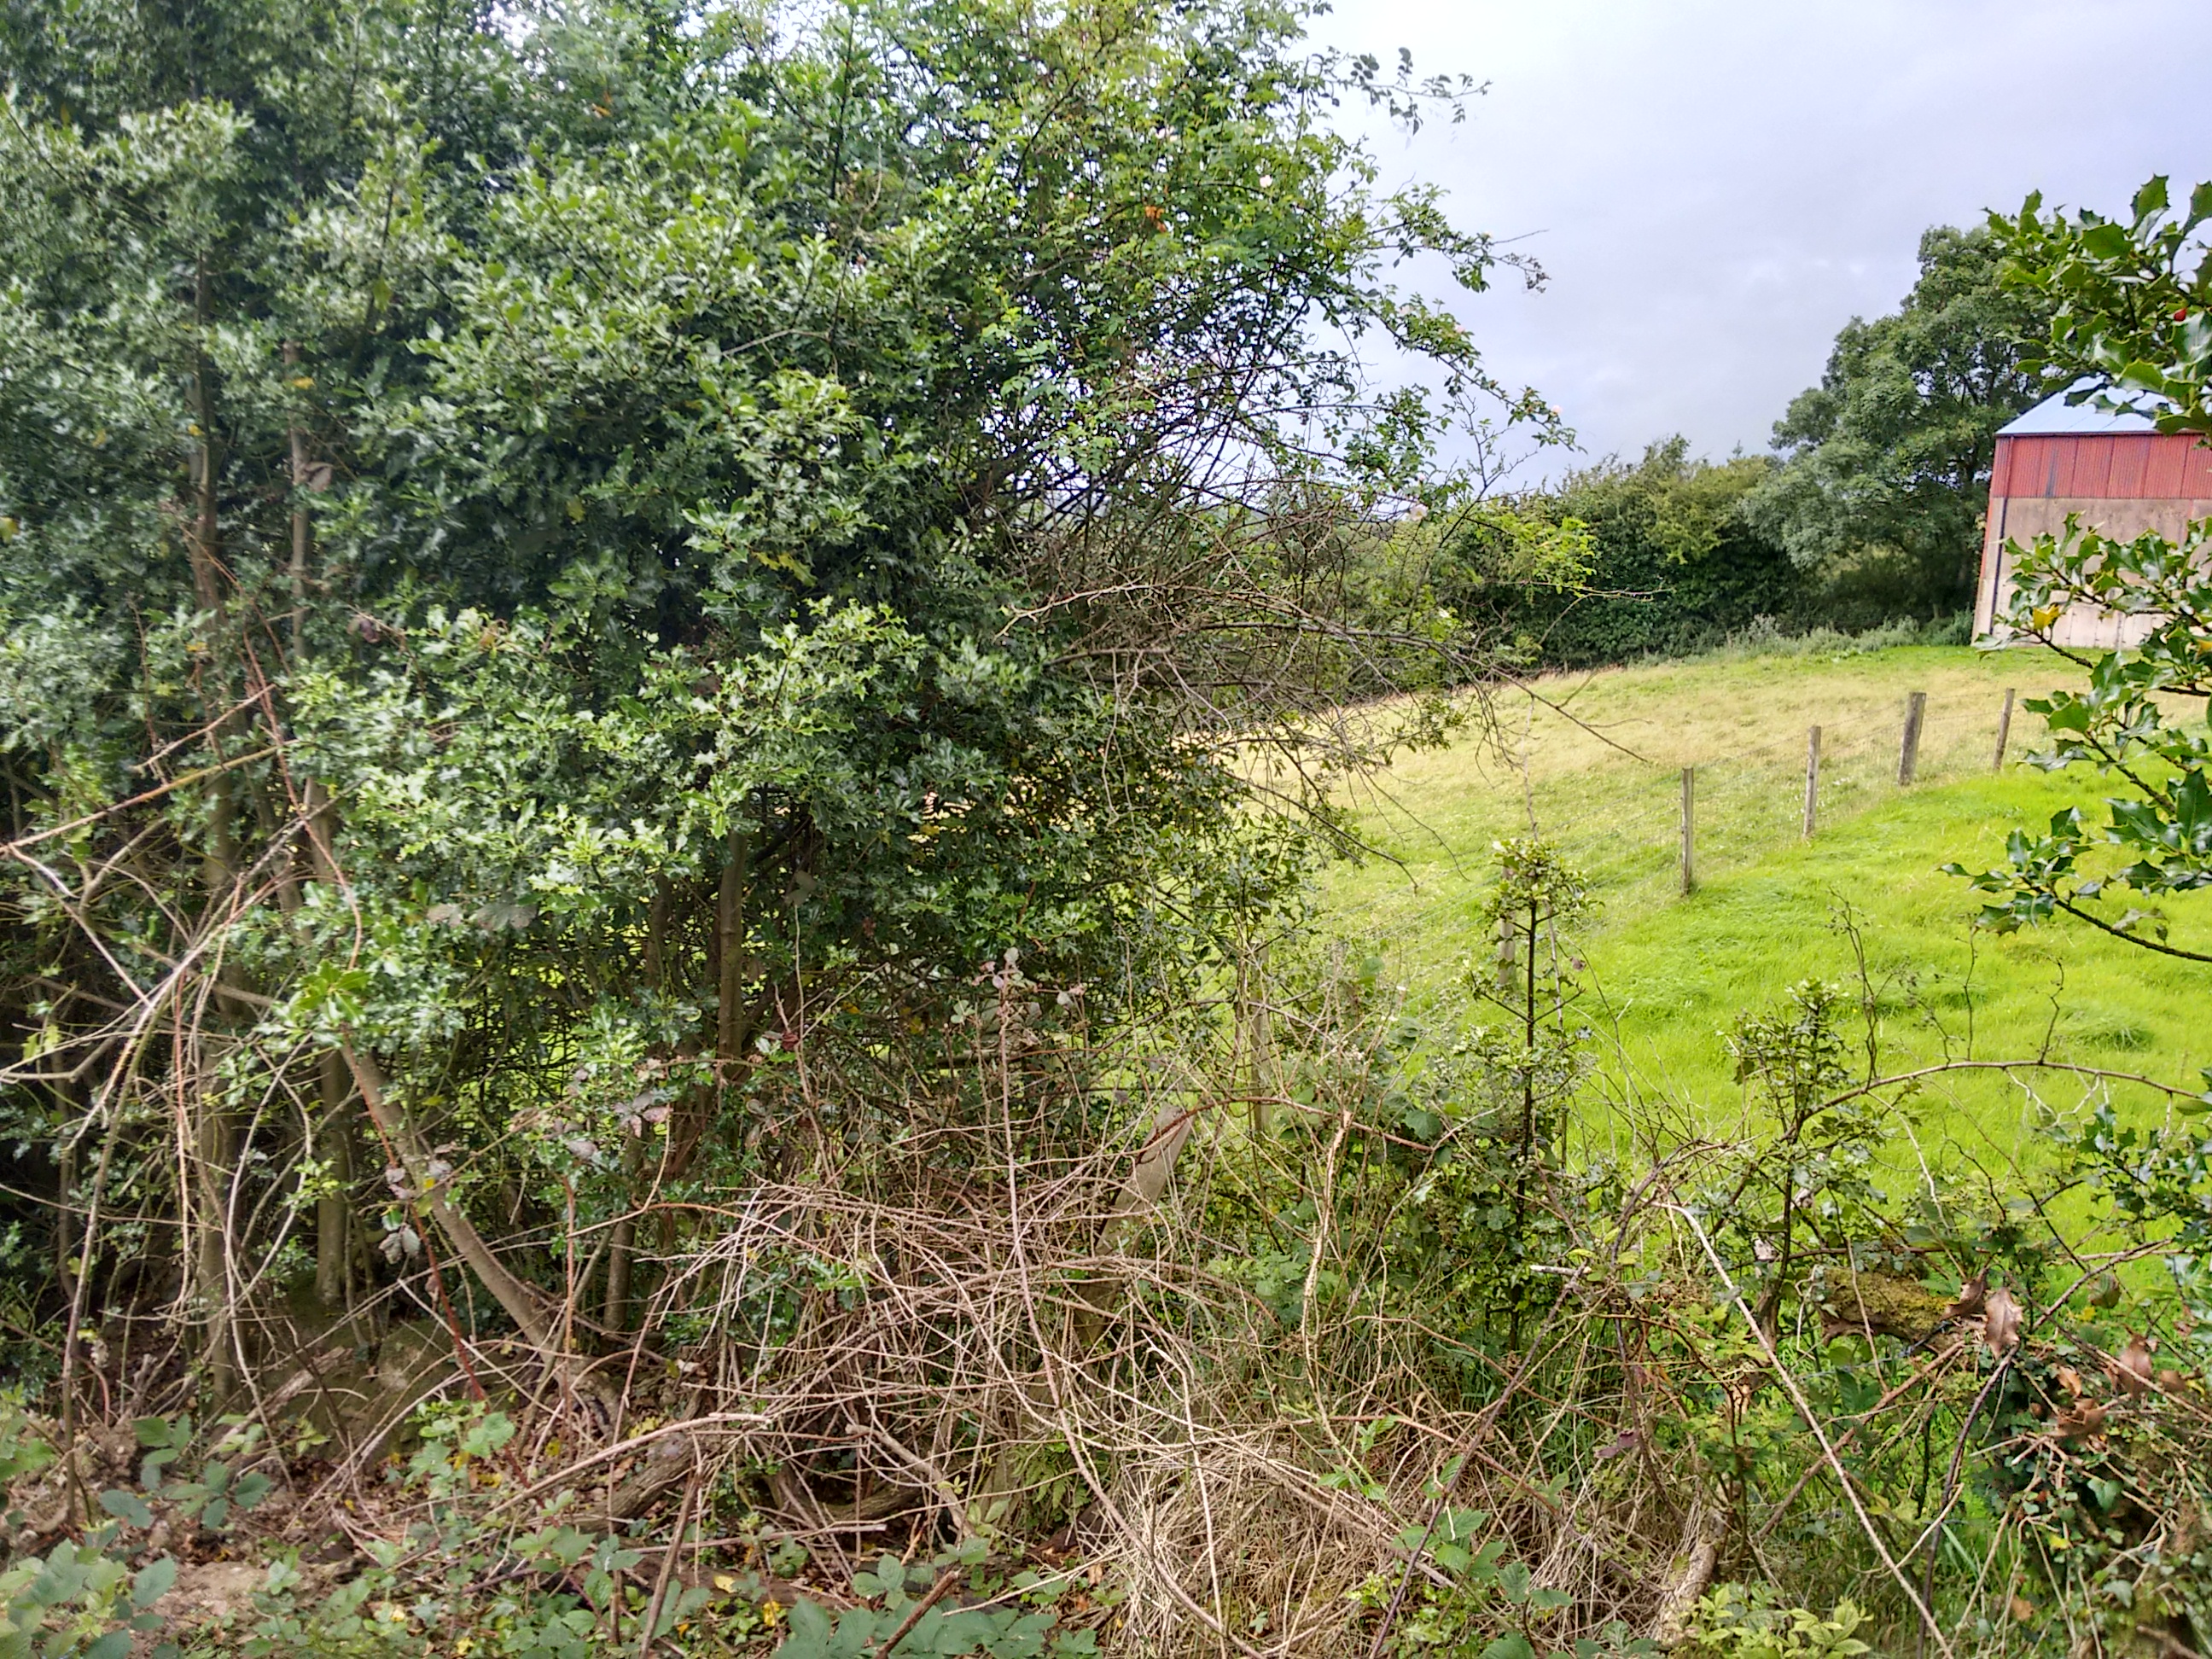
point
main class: Grassland
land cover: Grassland without tree/shrub cover
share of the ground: > 75 %
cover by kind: herbaceous plants 100 %
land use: Agriculture (excluding fallow land and kitchen gardens)
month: August
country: GB
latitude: 54.5982
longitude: -6.8675
